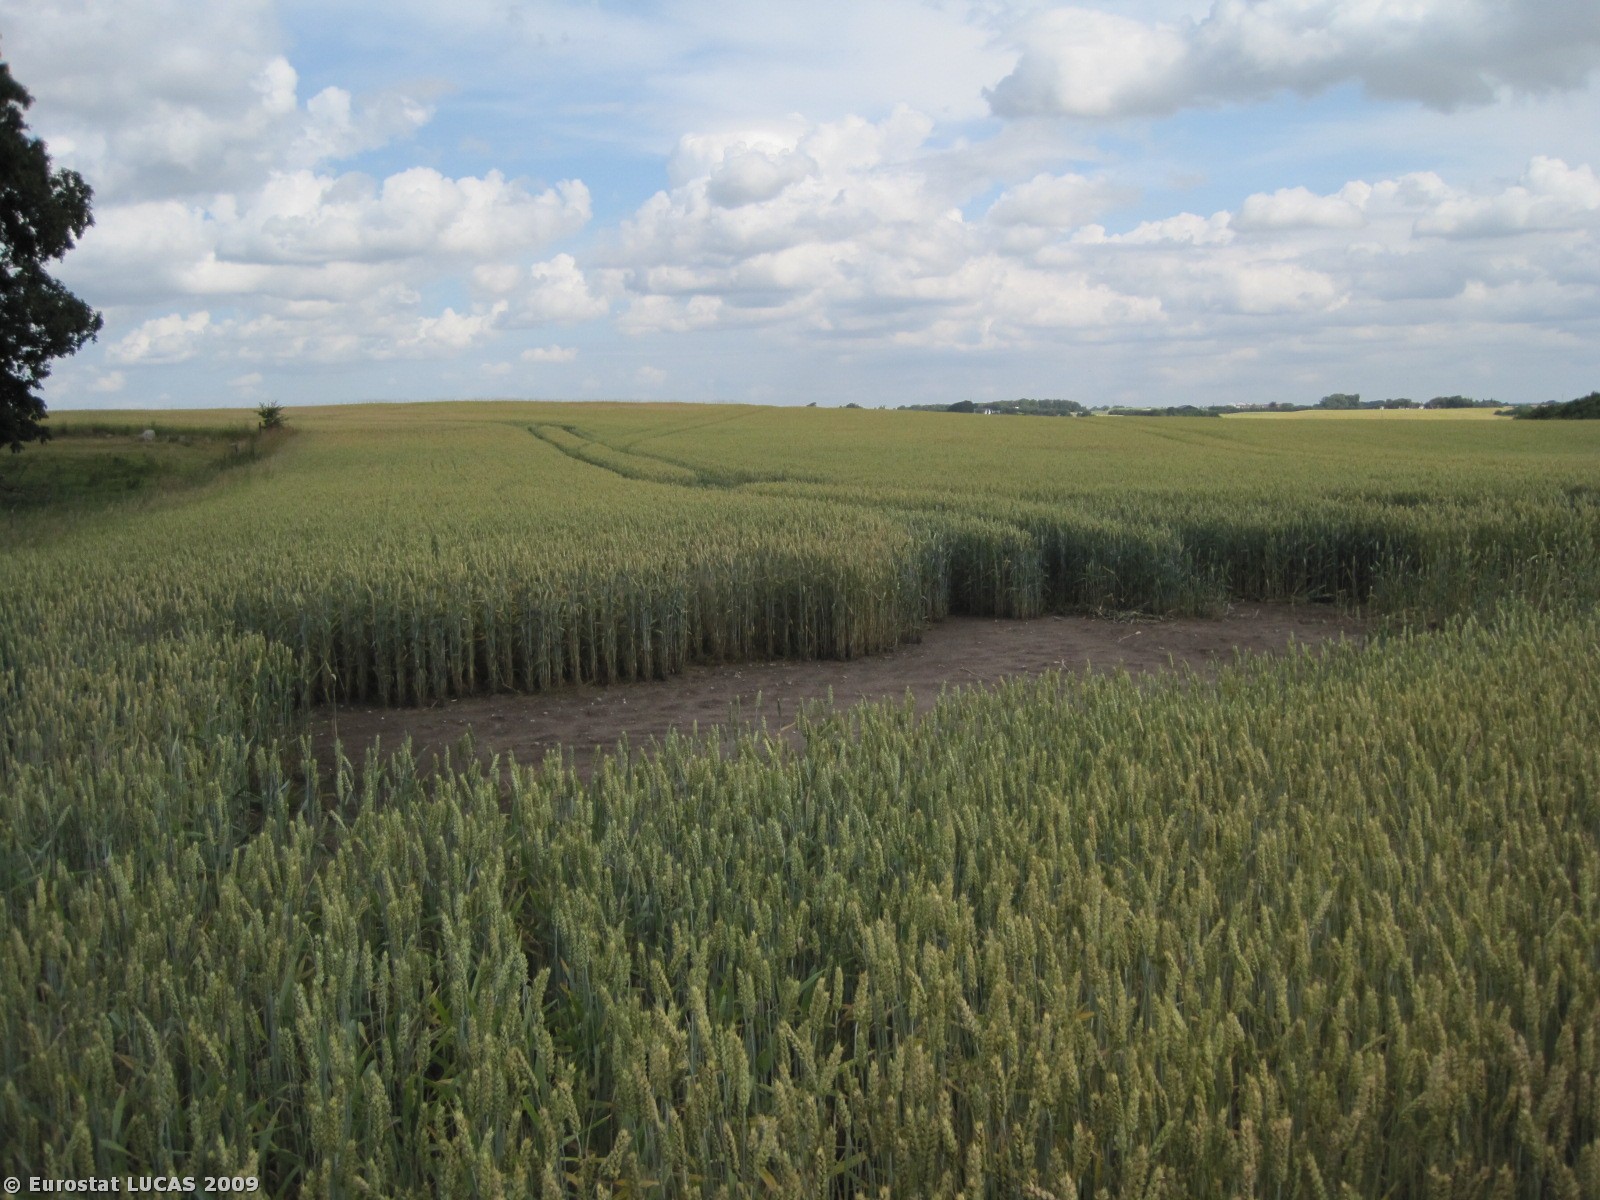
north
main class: Cropland
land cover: Common wheat
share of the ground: > 75 %
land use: Agriculture (excluding fallow land and kitchen gardens)
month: July
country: DK
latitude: 56.6727
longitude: 9.6904
